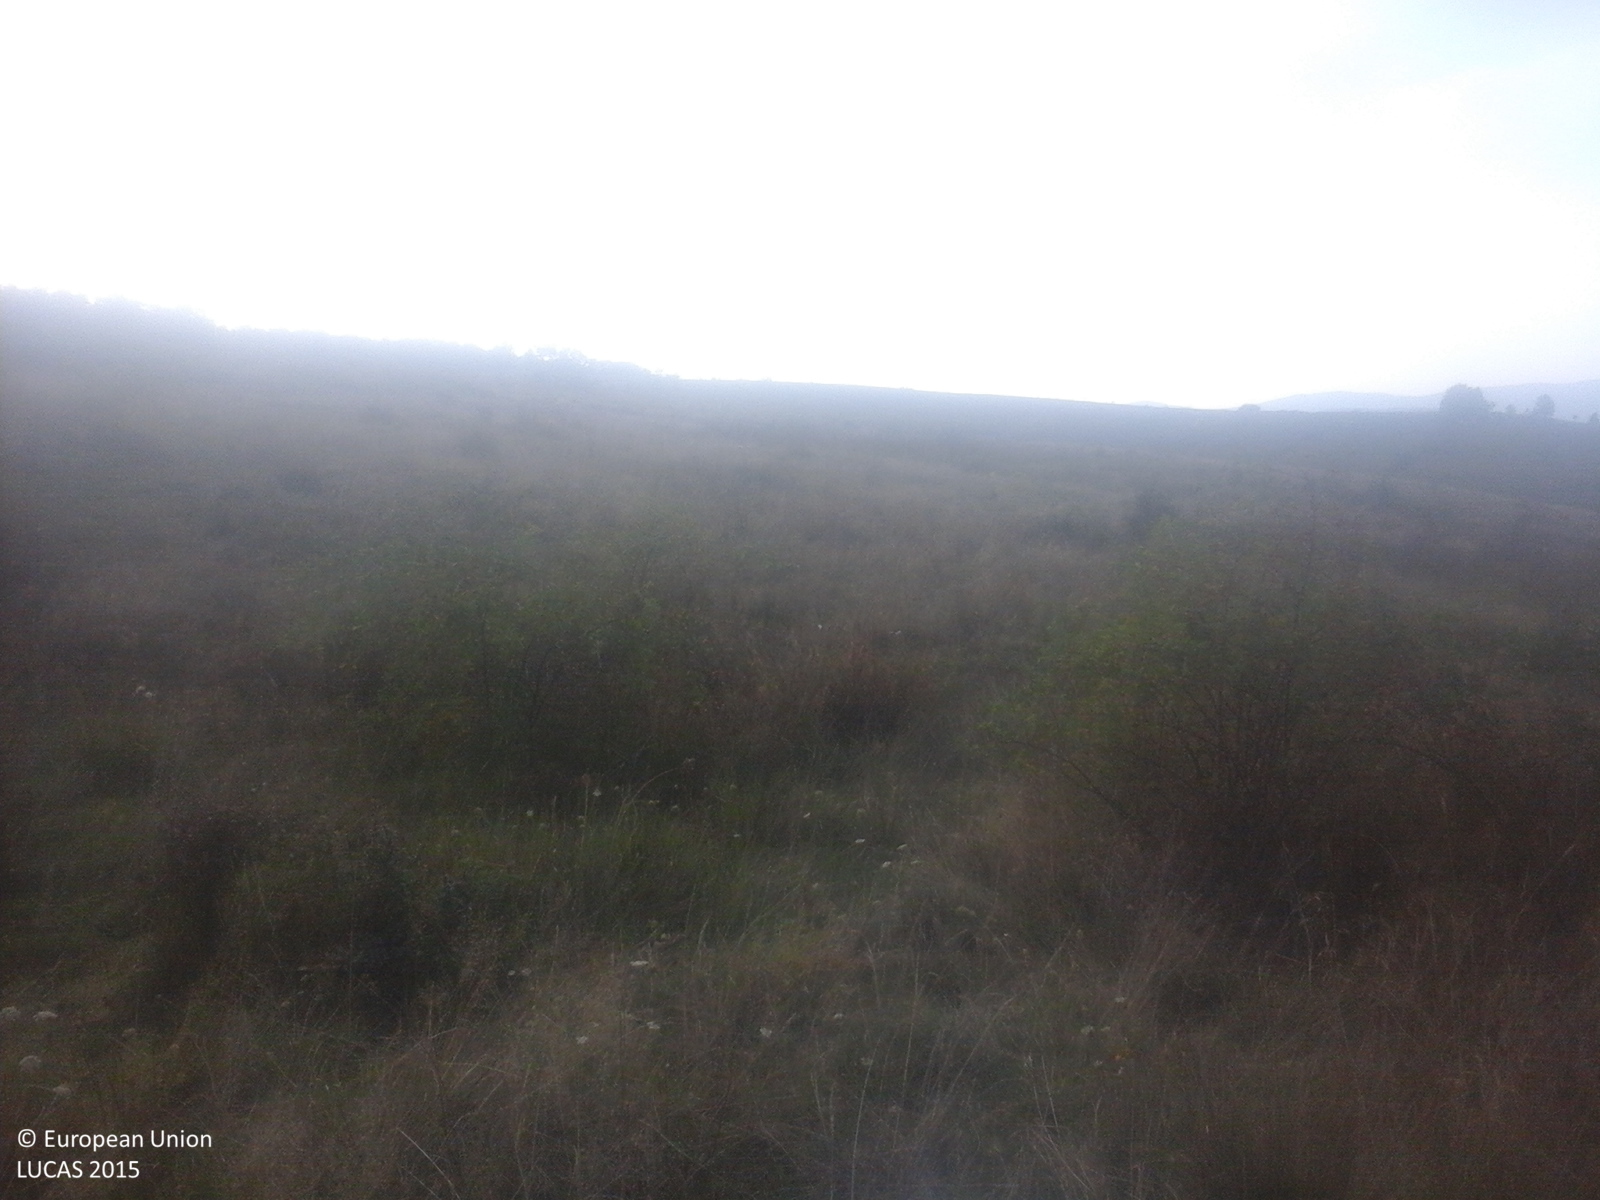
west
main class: Shrubland
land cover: Shrubland without tree cover
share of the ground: > 75 %
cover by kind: shrubs 60 %, herbaceous plants 40 %
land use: Agriculture (excluding fallow land and kitchen gardens)
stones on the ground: < 10 %
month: September
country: RO
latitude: 47.0328
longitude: 23.1317
